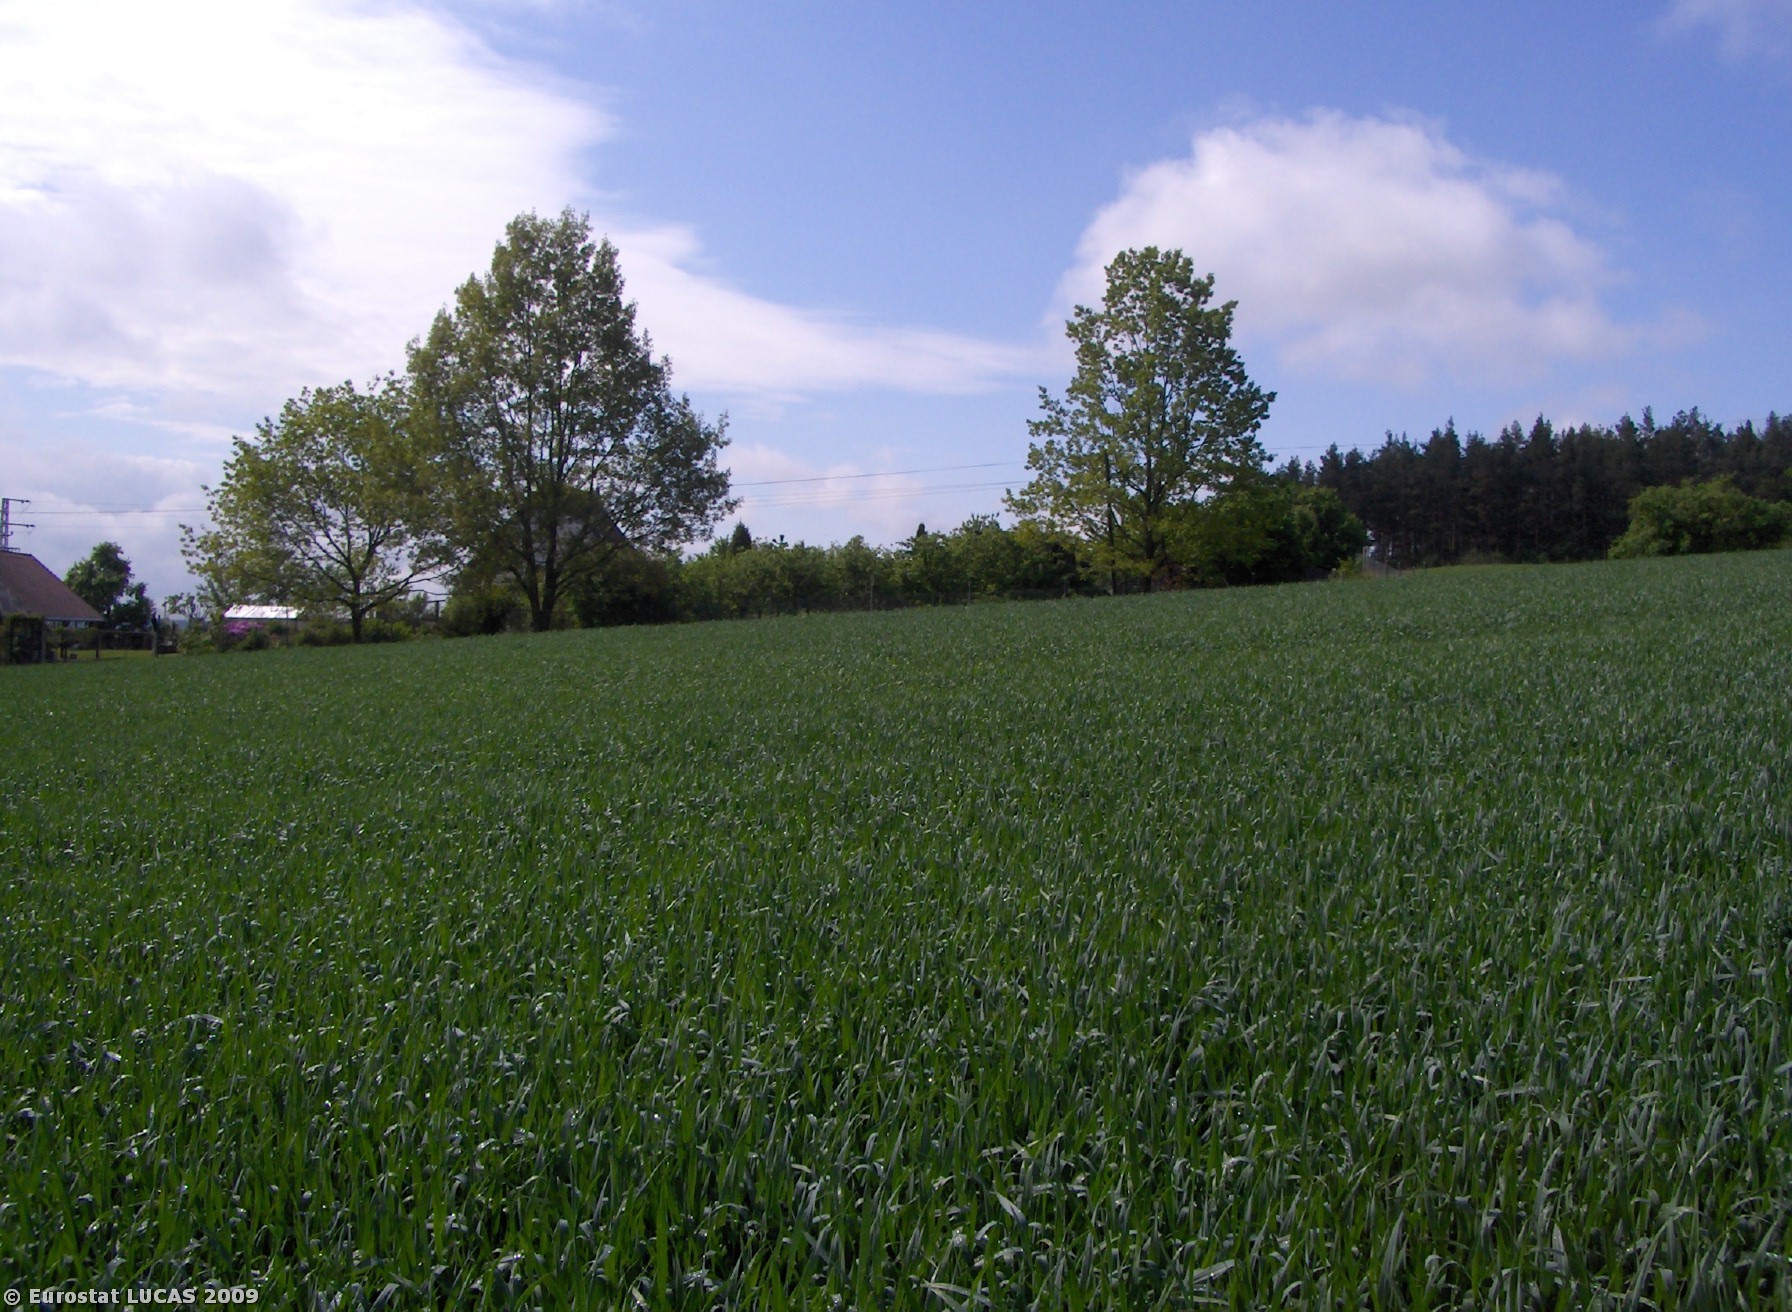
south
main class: Cropland
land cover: Common wheat
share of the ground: > 75 %
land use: Agriculture (excluding fallow land and kitchen gardens)
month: May
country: CZ
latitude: 49.4530
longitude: 14.3465
